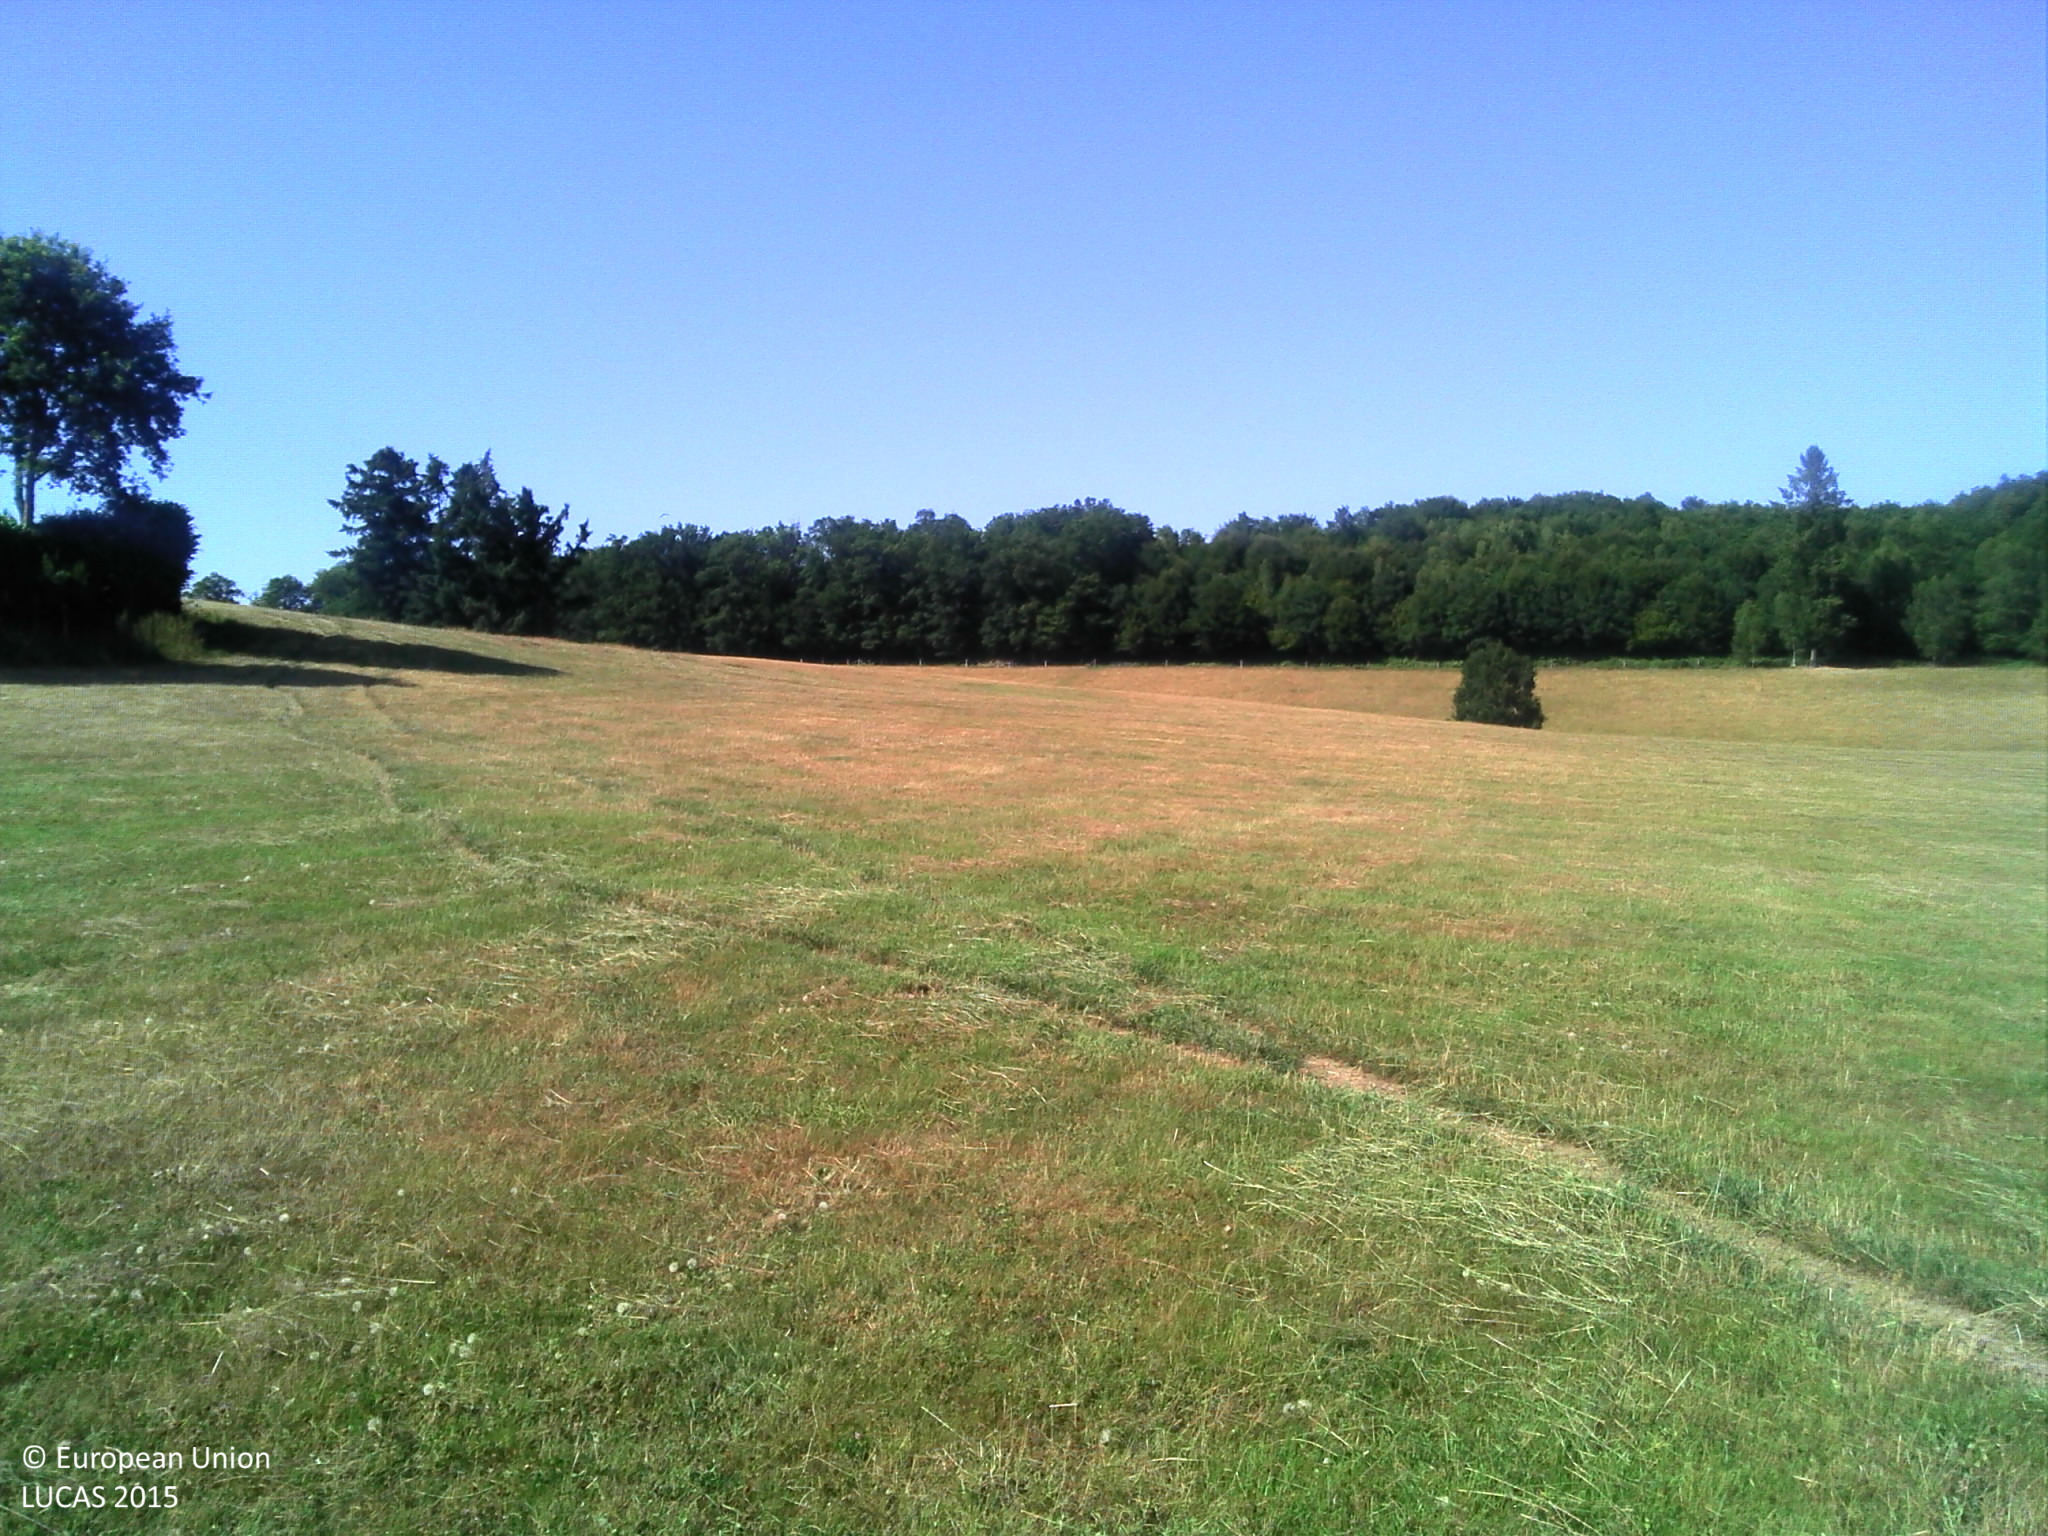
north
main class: Grassland
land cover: Grassland without tree/shrub cover
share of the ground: > 75 %
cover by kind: herbaceous plants 100 %
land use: Agriculture (excluding fallow land and kitchen gardens)
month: July
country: FR
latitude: 46.0271
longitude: 1.6858
